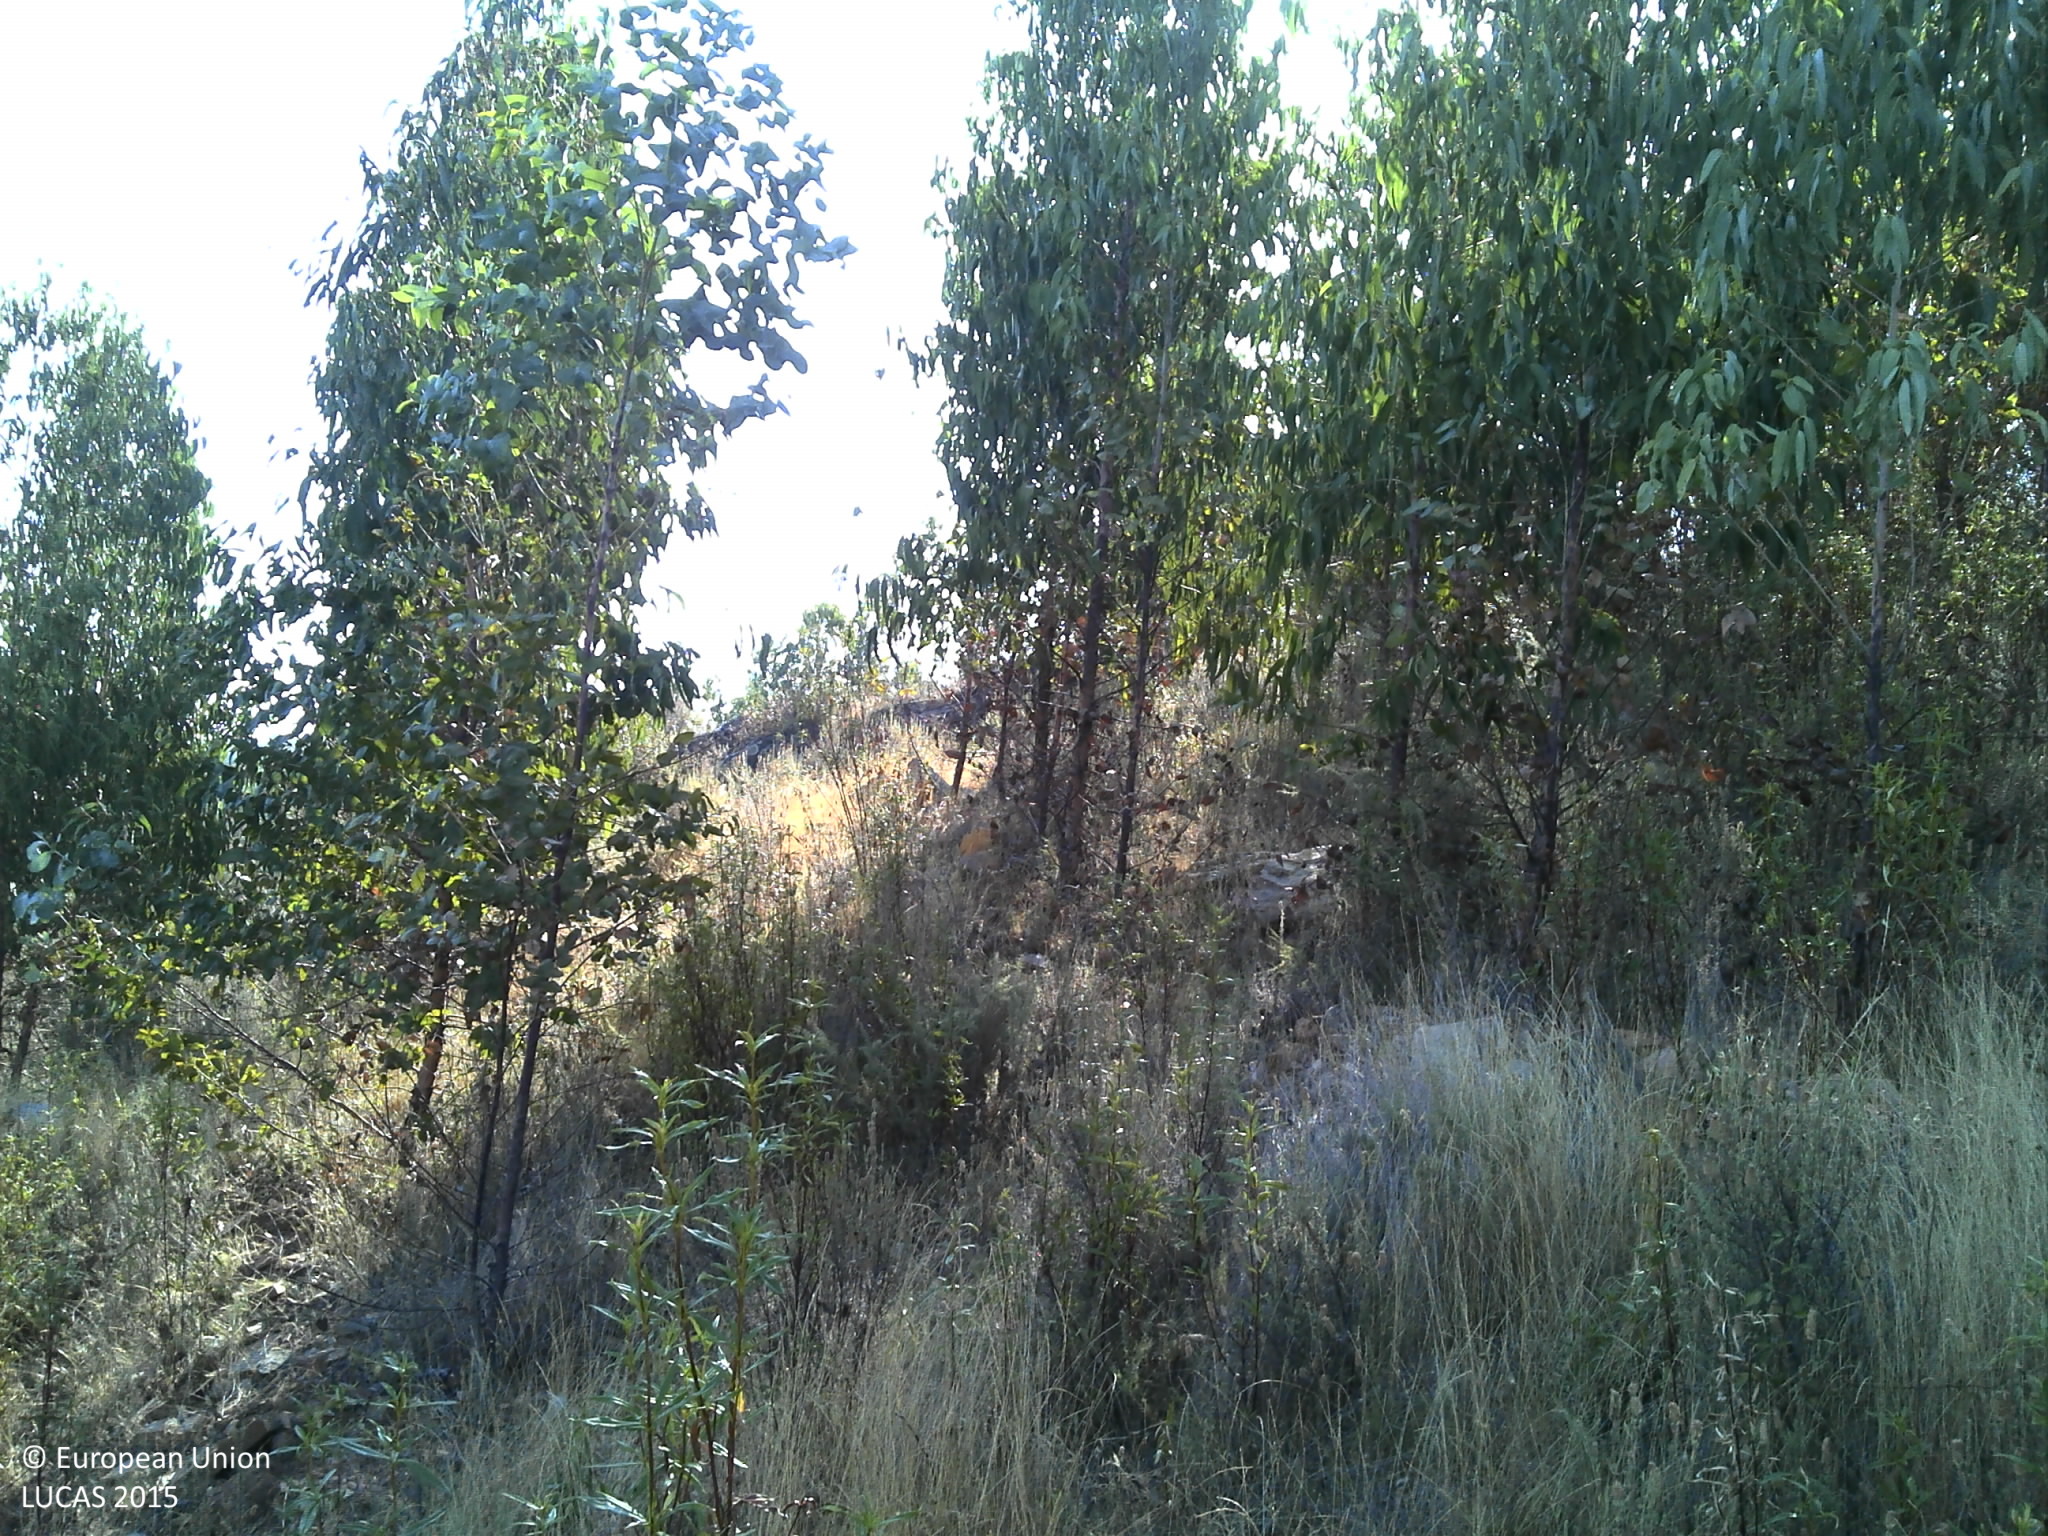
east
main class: Woodland
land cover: Broadleaved woodland
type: exotic forest
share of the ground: 10 - 25 %
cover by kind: broadleaved forest trees 20 %, shrubs 20 %, herbaceous plants 20 %, consolidated bare surface 20 %, unconsolidated bare surface 20 %
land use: Forestry
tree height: > 5 m
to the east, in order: Broadleaved woodland; Shrubland without tree cover; Broadleaved woodland; Tracks; Broadleaved woodland; Tracks; Shrubland with sparse tree cover; Tracks; Shrubland without tree cover; Broadleaved woodland
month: July
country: PT
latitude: 38.6331
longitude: -7.4567
